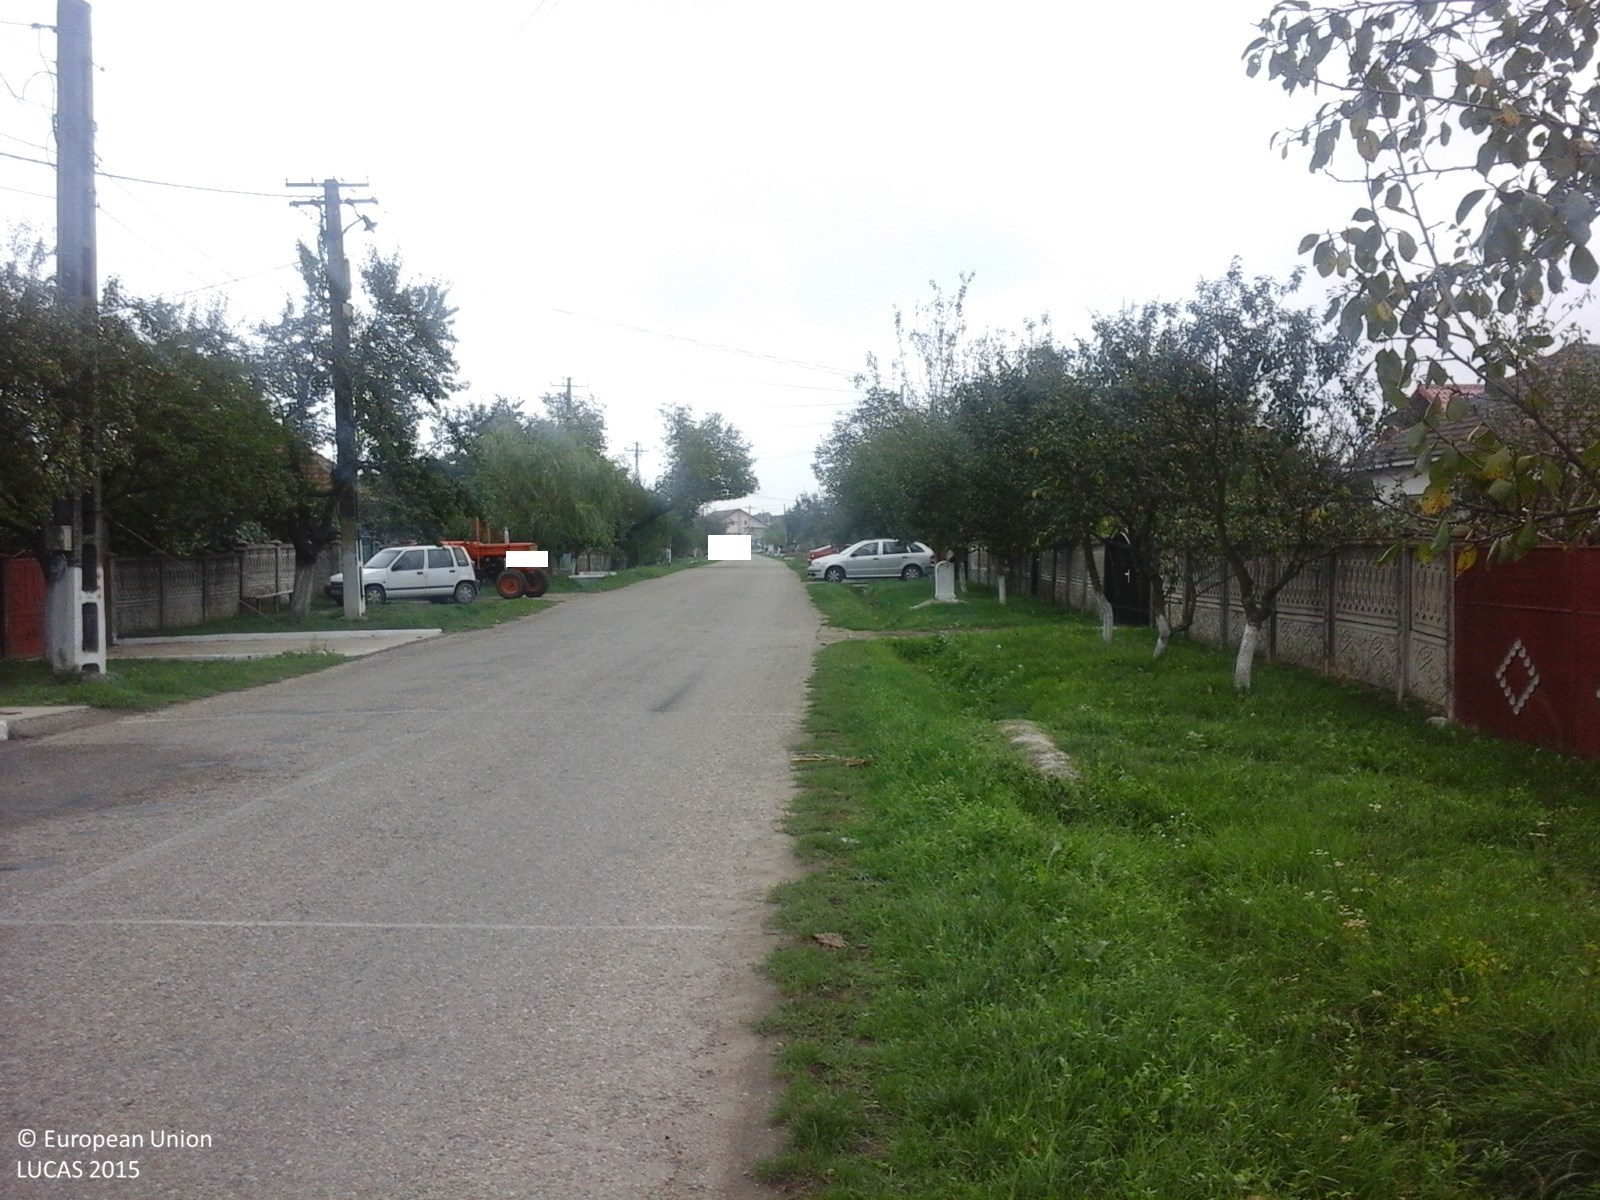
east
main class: Cropland
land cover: Tomatoes
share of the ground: > 75 %
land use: Kitchen garden
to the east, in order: Tomatoes; Artificial constructions in urban areas; Grassland without tree/shrub cover; Artificial constructions in urban areas; Lucerne; Vineyards; Artificial constructions in urban areas
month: September
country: RO
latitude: 44.9829
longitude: 23.3326
